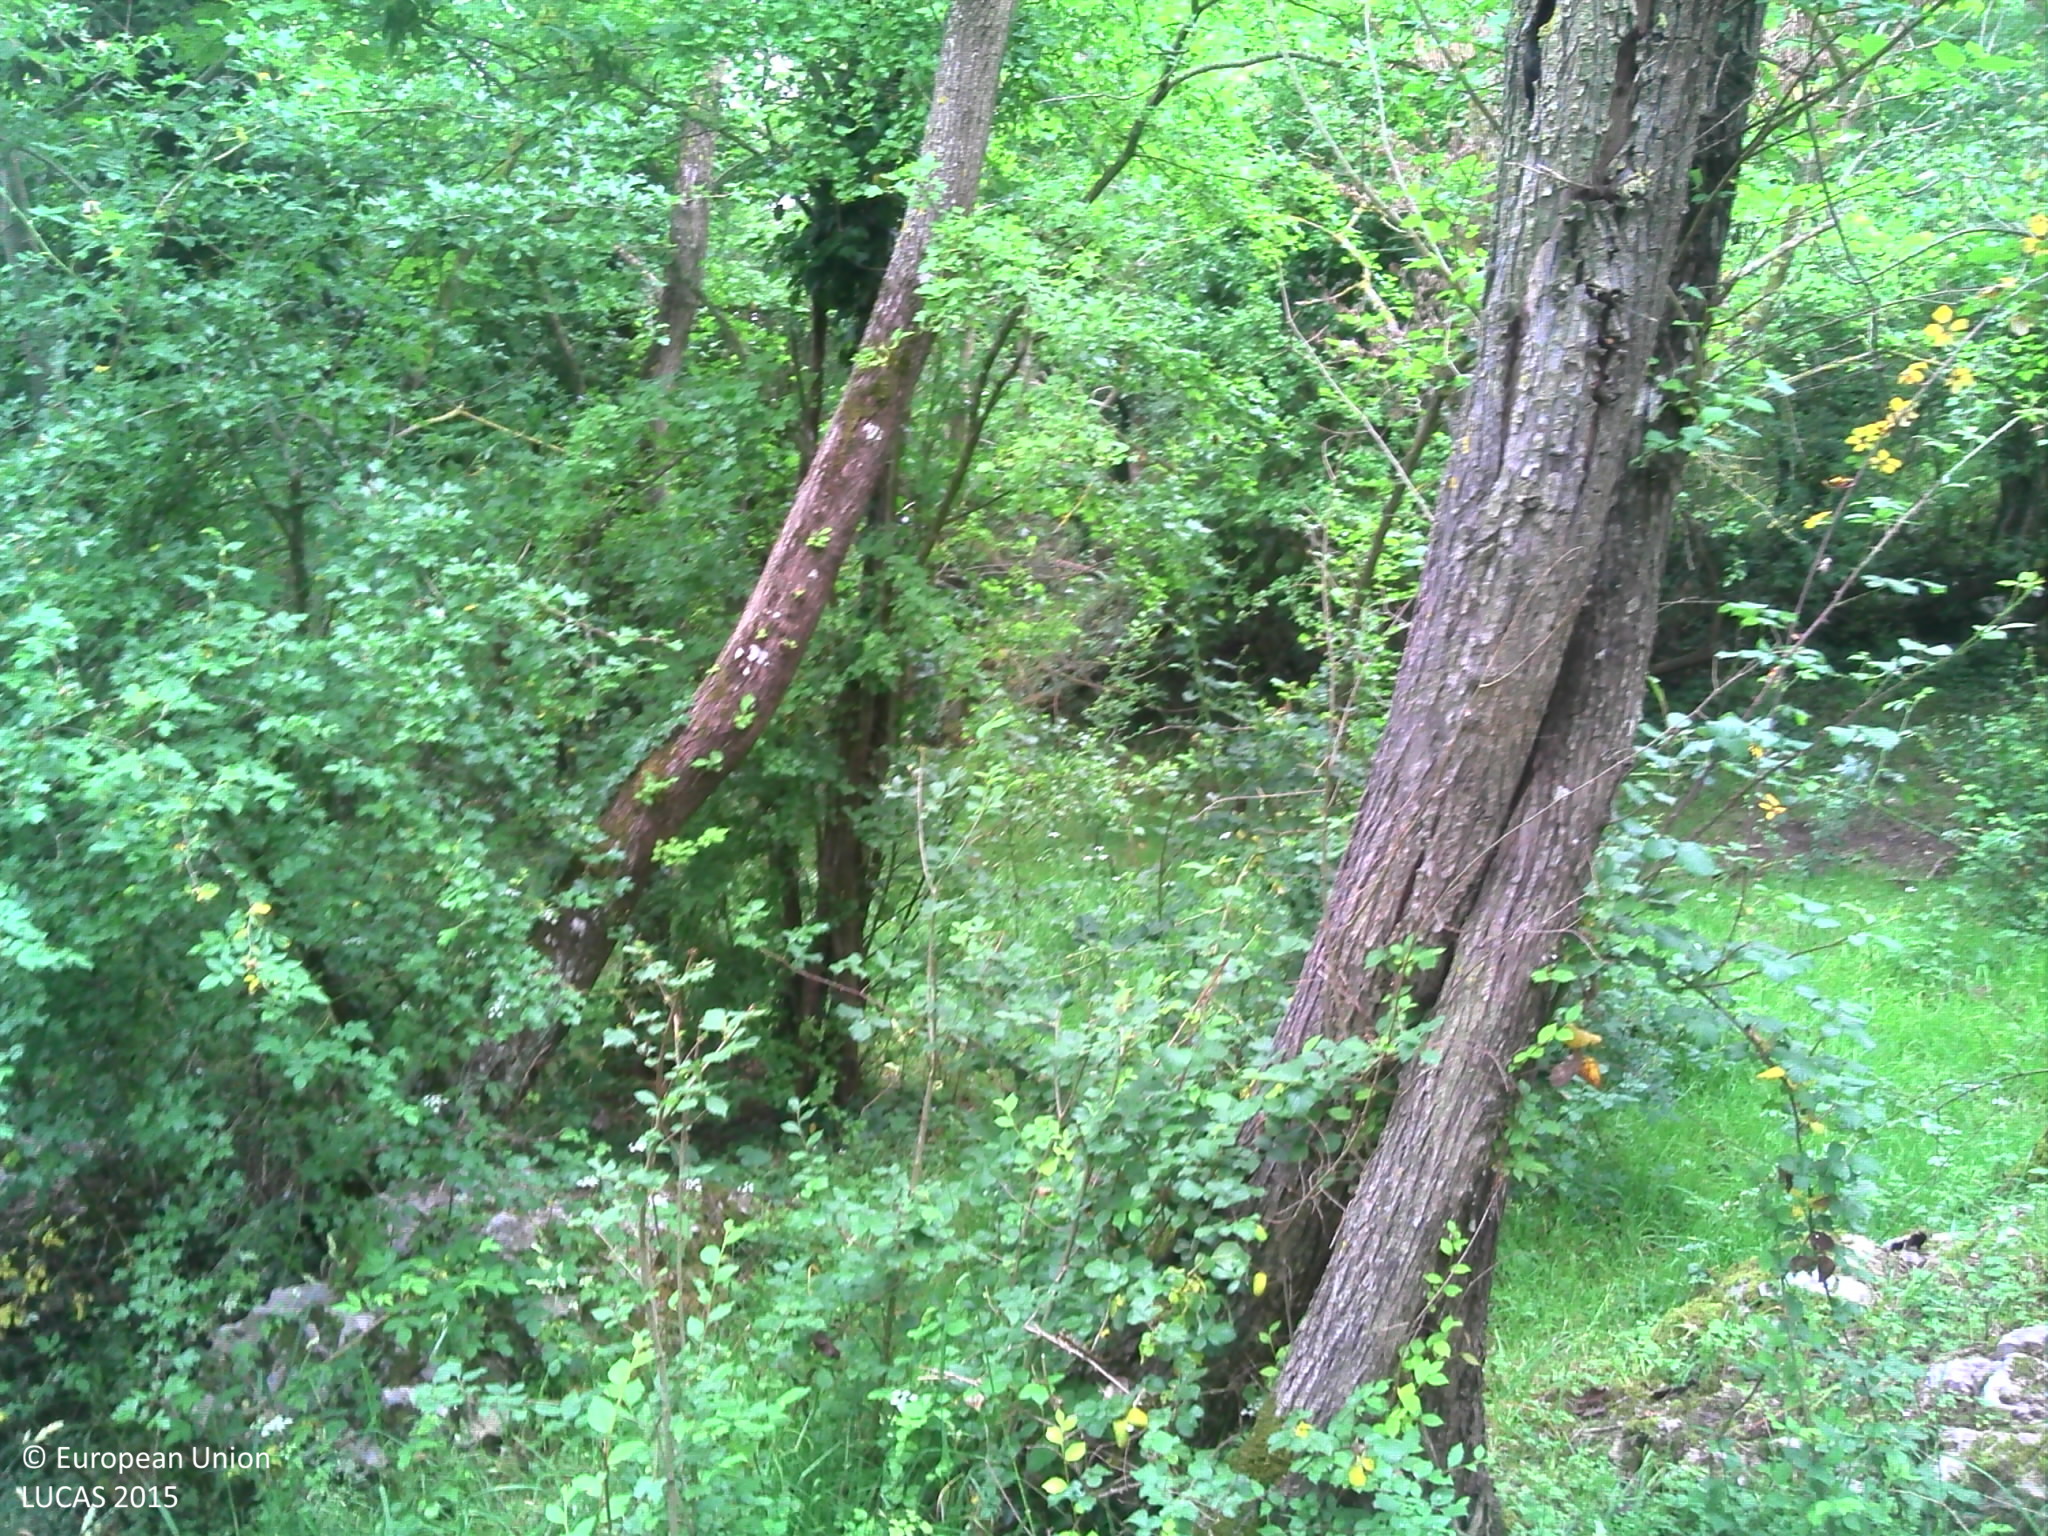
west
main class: Woodland
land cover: Broadleaved woodland
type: mesophytic deciduous forest
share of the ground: > 75 %
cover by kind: broadleaved forest trees 90 %, lichens and mosses 10 %
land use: Forestry
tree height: > 5 m
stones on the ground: 10 - 25 %
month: June
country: FR
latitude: 48.8051
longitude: 0.0443
